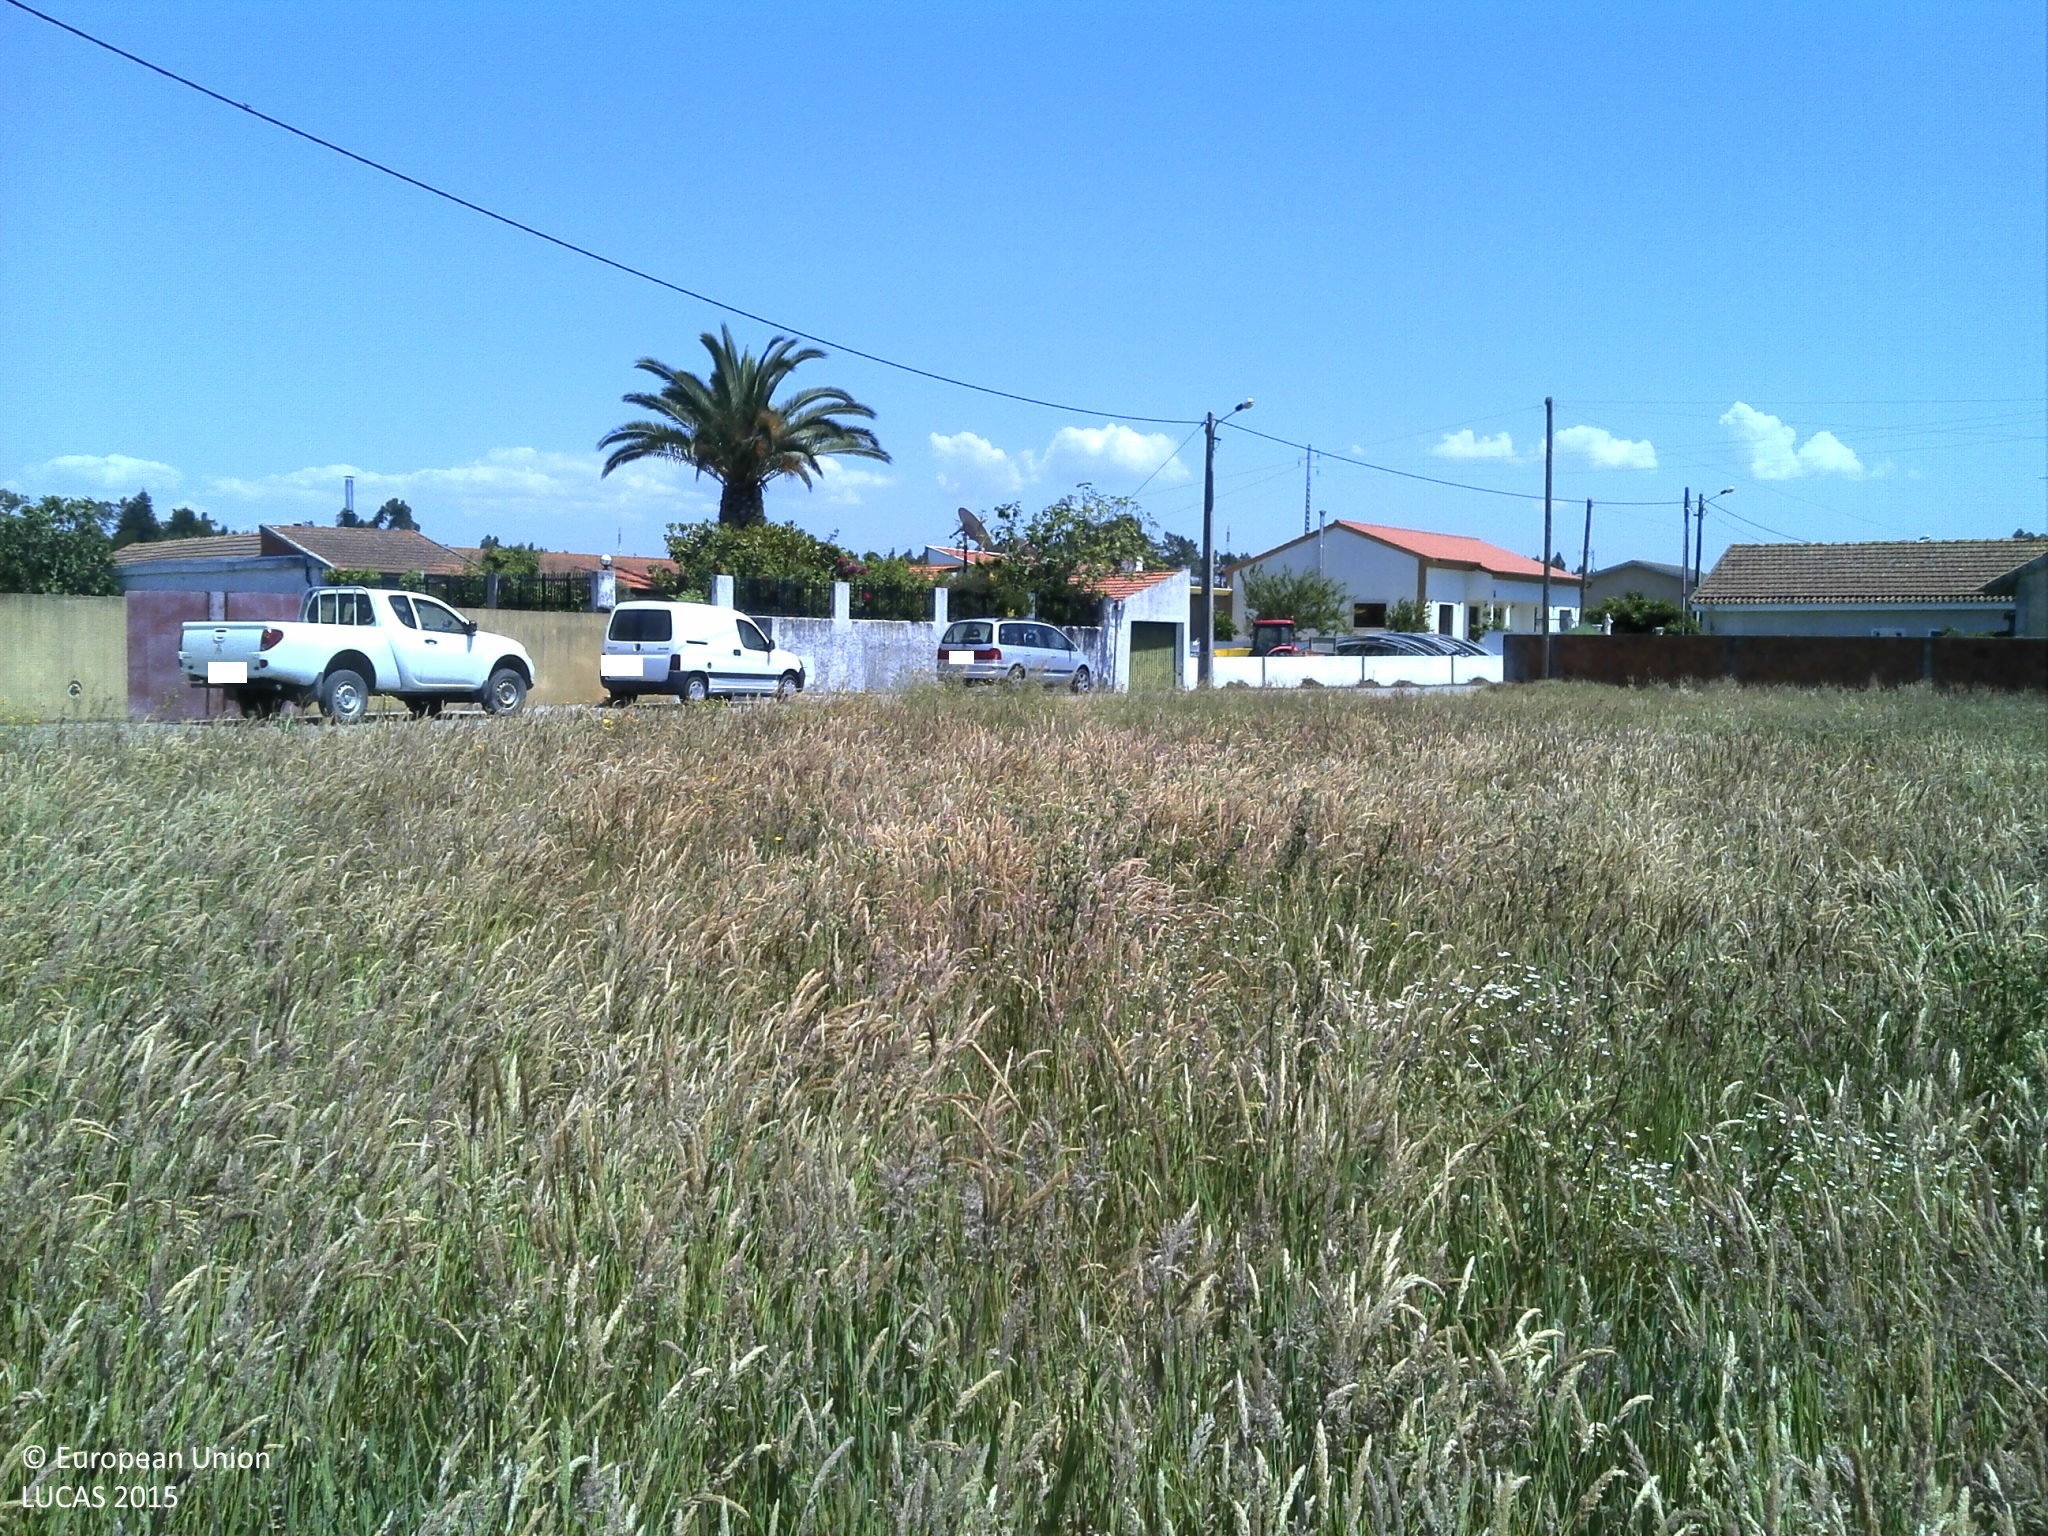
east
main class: Grassland
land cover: Grassland without tree/shrub cover
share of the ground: 50 - 75 %
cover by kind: herbaceous plants 75 %, unconsolidated bare surface 25 %
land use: Agriculture (excluding fallow land and kitchen gardens)
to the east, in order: Grassland without tree/shrub cover; Artificial constructions in urban areas; Spontaneously vegetated surfaces; Other root crops; Spontaneously vegetated surfaces; Potatoes; Spontaneously vegetated surfaces; Tracks; Spontaneously vegetated surfaces; Ditches and canals; Grassland without tree/shrub cover
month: May
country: PT
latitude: 40.4693
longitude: -8.6956
